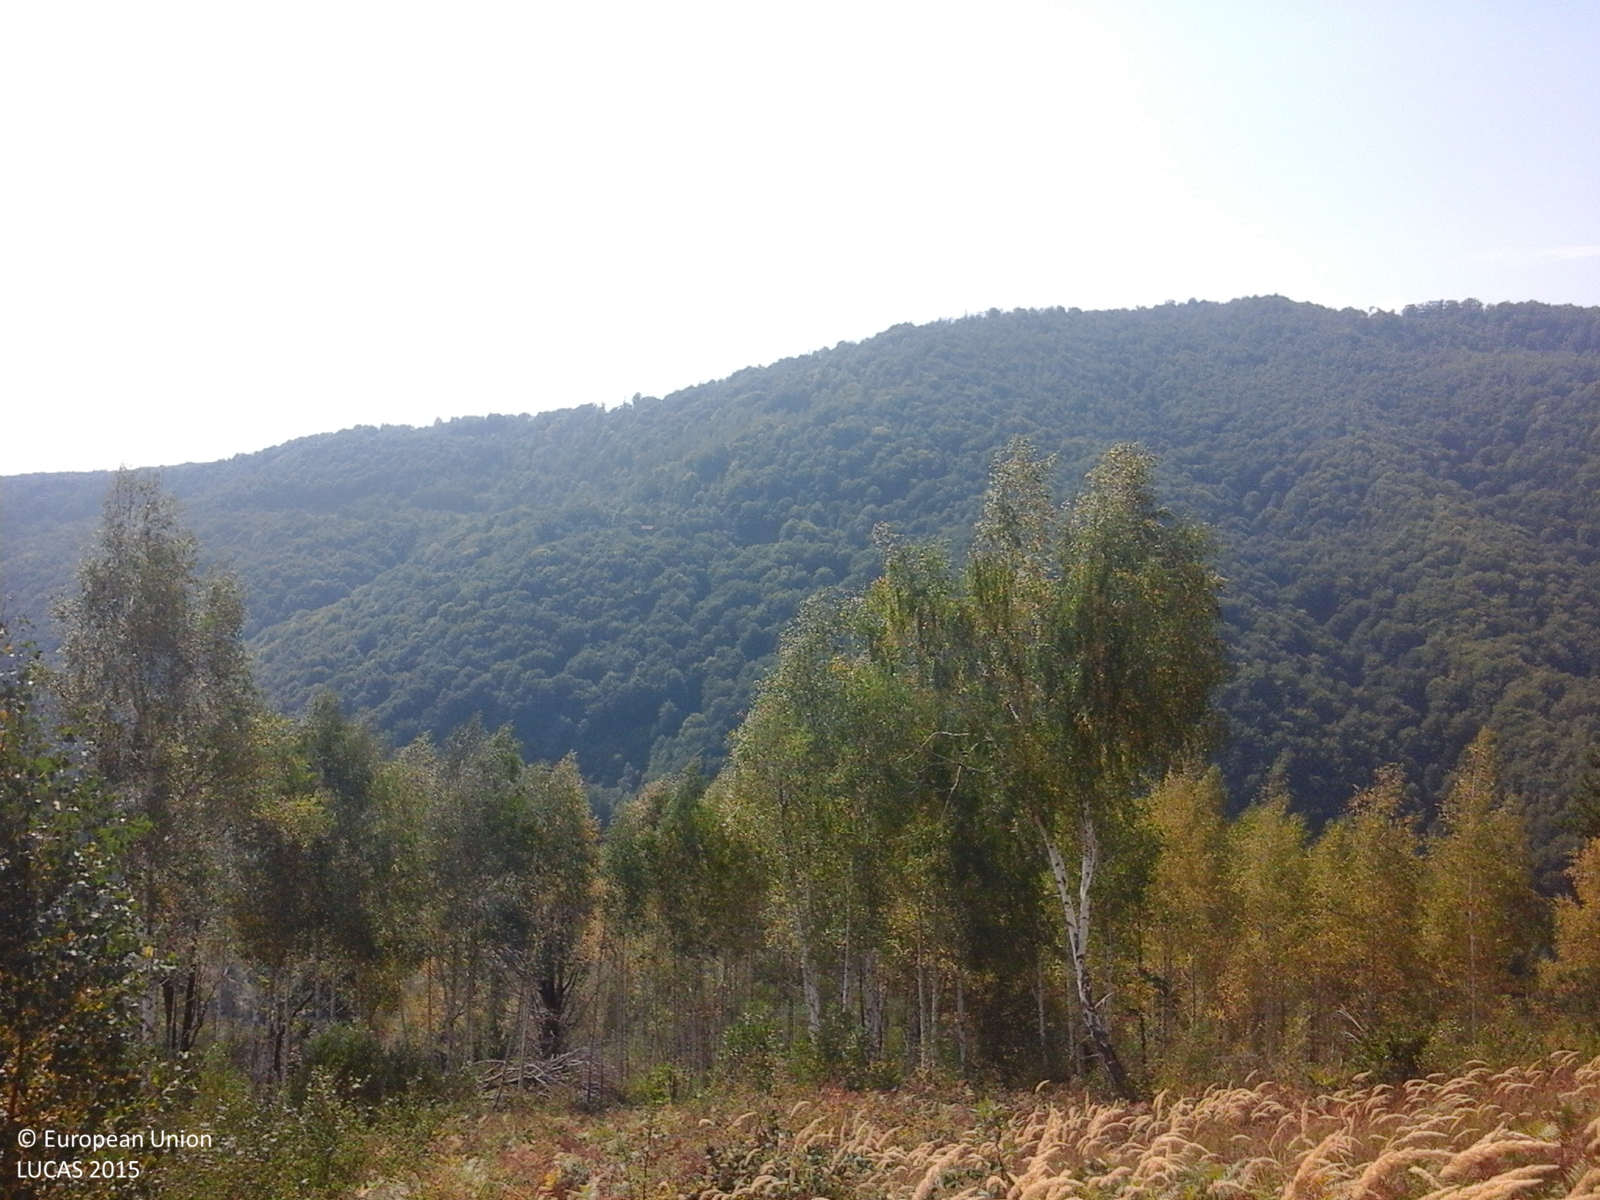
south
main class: Grassland
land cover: Spontaneously vegetated surfaces
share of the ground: > 75 %
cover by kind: herbaceous plants 100 %
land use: Fallow land
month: September
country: RO
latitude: 45.1686
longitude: 22.2669
